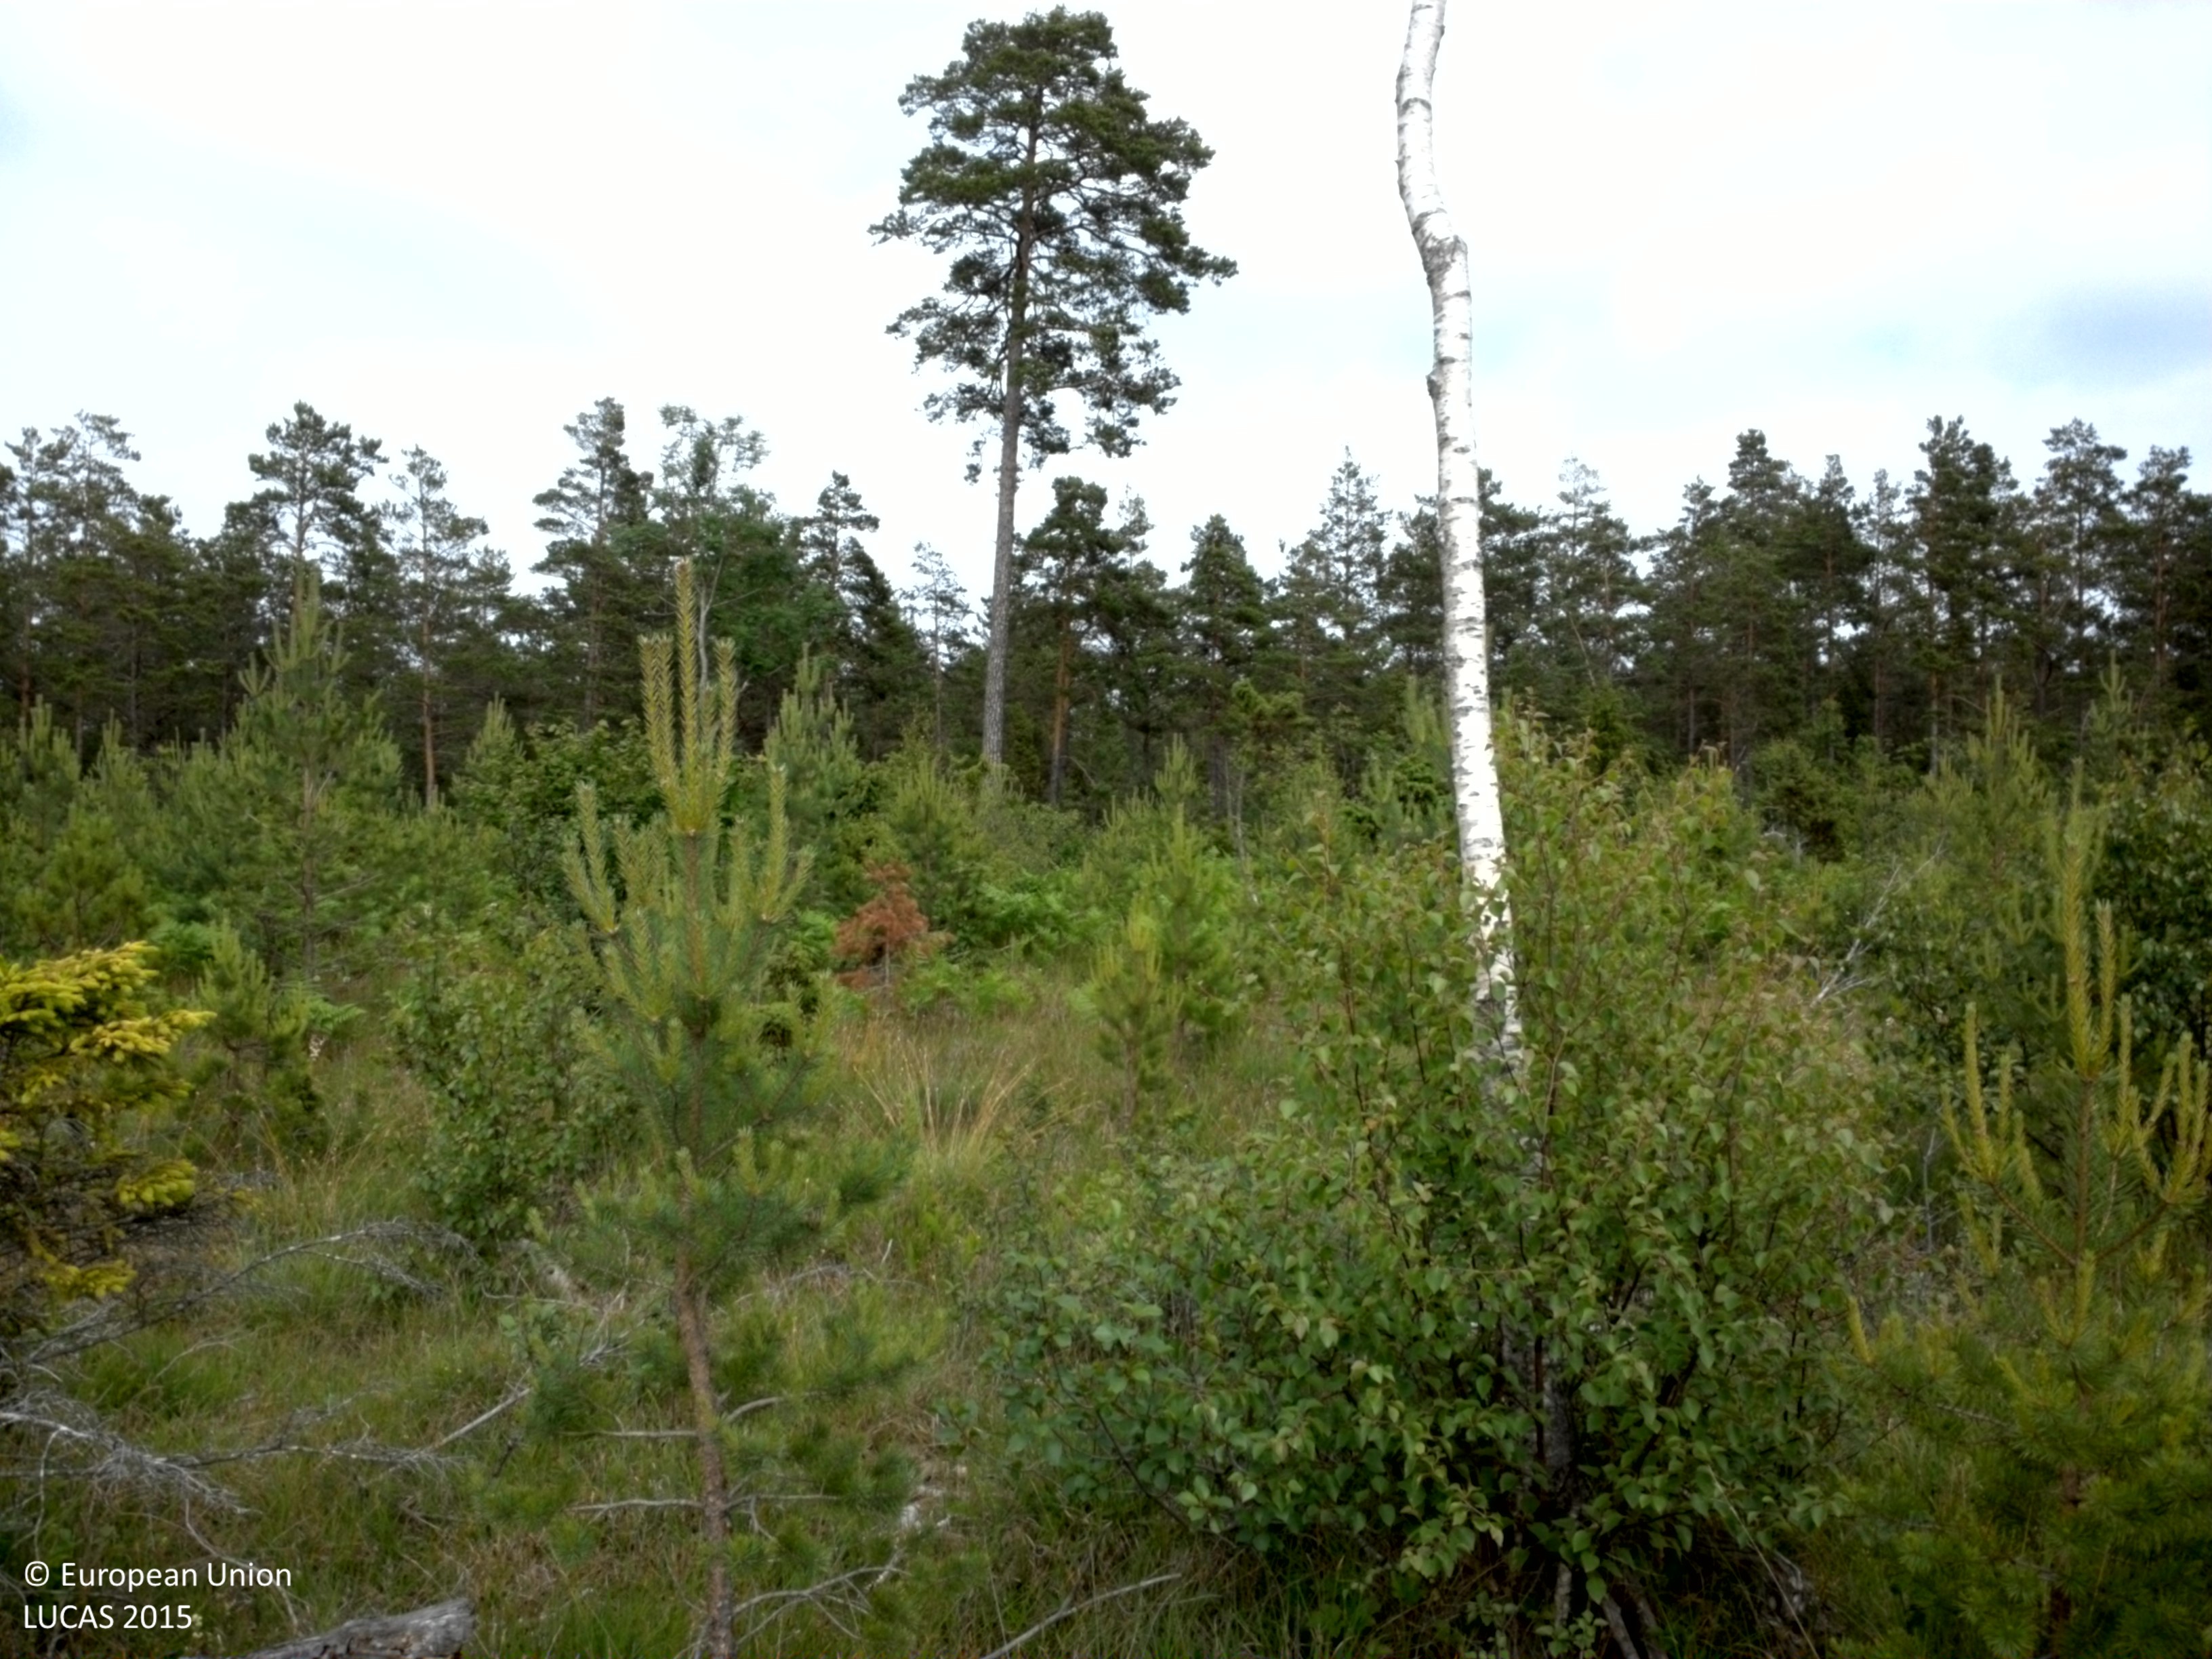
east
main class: Woodland
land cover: Pine dominated mixed woodland
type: hemiboreal forest and nemoral coniferous forest and mixed broadleaved-coniferous forest
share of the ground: 50 - 75 %
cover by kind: coniferous forest trees 45 %, herbaceous plants 30 %, broadleaved forest trees 25 %
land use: Forestry
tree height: < 5 m
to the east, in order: Pine dominated mixed woodland; Pine dominated coniferous woodland; Grassland with sparse tree/shrub cover; Pine dominated coniferous woodland
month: June
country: SE
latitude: 57.8788
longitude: 18.7605
